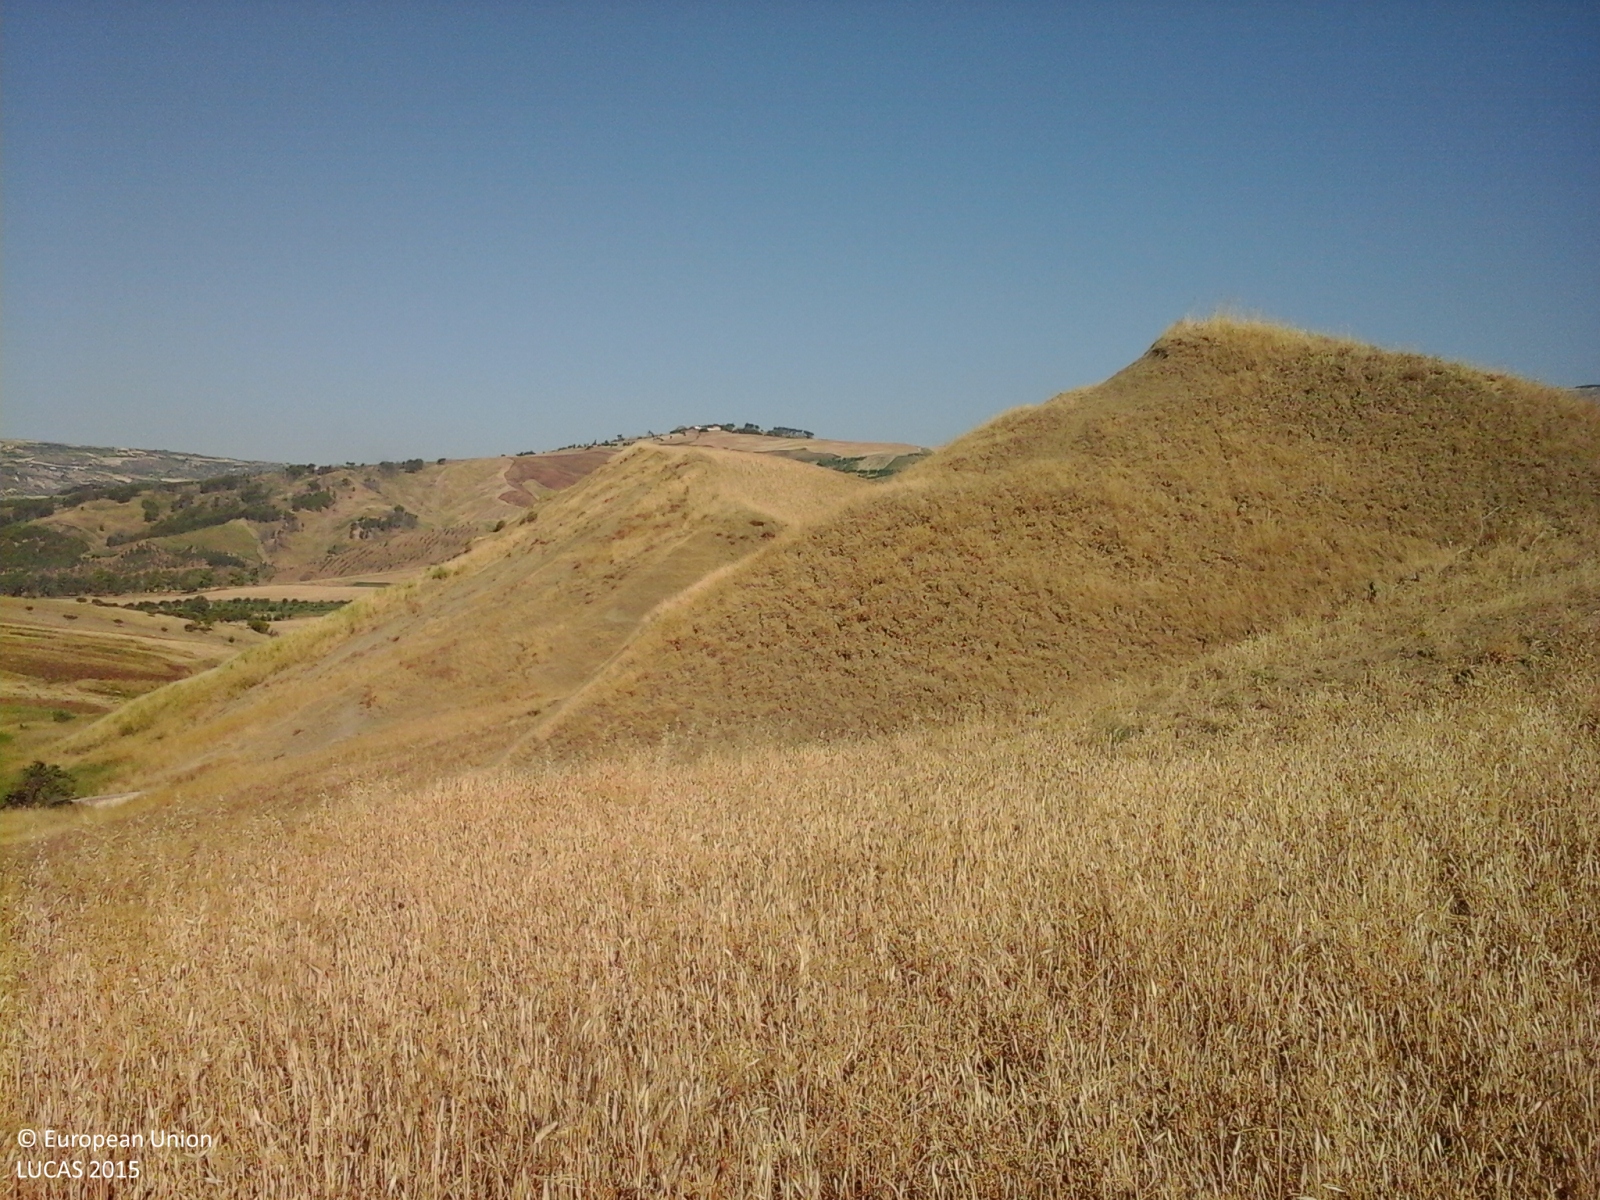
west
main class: Cropland
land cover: Durum wheat
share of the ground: > 75 %
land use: Agriculture (excluding fallow land and kitchen gardens)
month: July
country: IT
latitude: 37.5545
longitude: 13.5390
